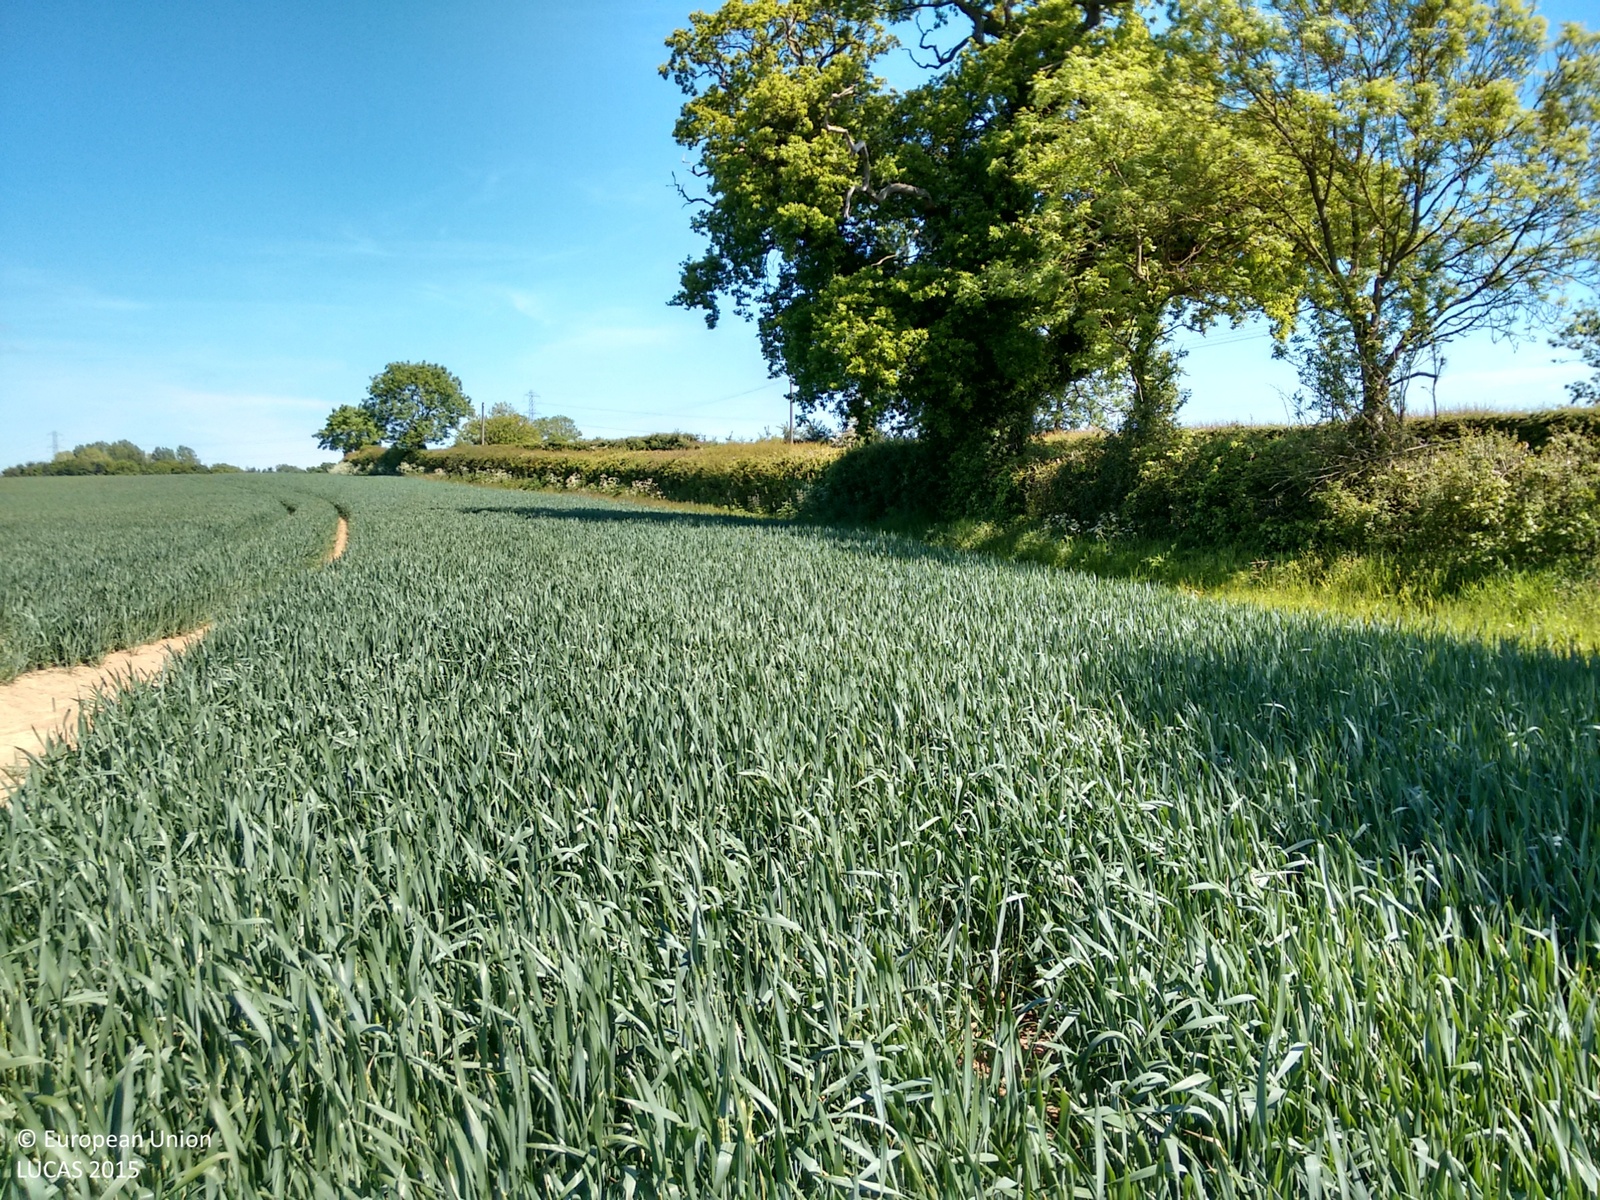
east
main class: Cropland
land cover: Common wheat
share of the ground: > 75 %
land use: Agriculture (excluding fallow land and kitchen gardens)
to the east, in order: Common wheat; Grass margins; Managed hedges; Grass margins; Paved roads, cycling and walking lanes; Electric lines; Grassland with sparse tree/shrub cover; Managed hedges; Rape and turnip rape
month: June
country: GB
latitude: 54.0543
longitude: -0.8713
